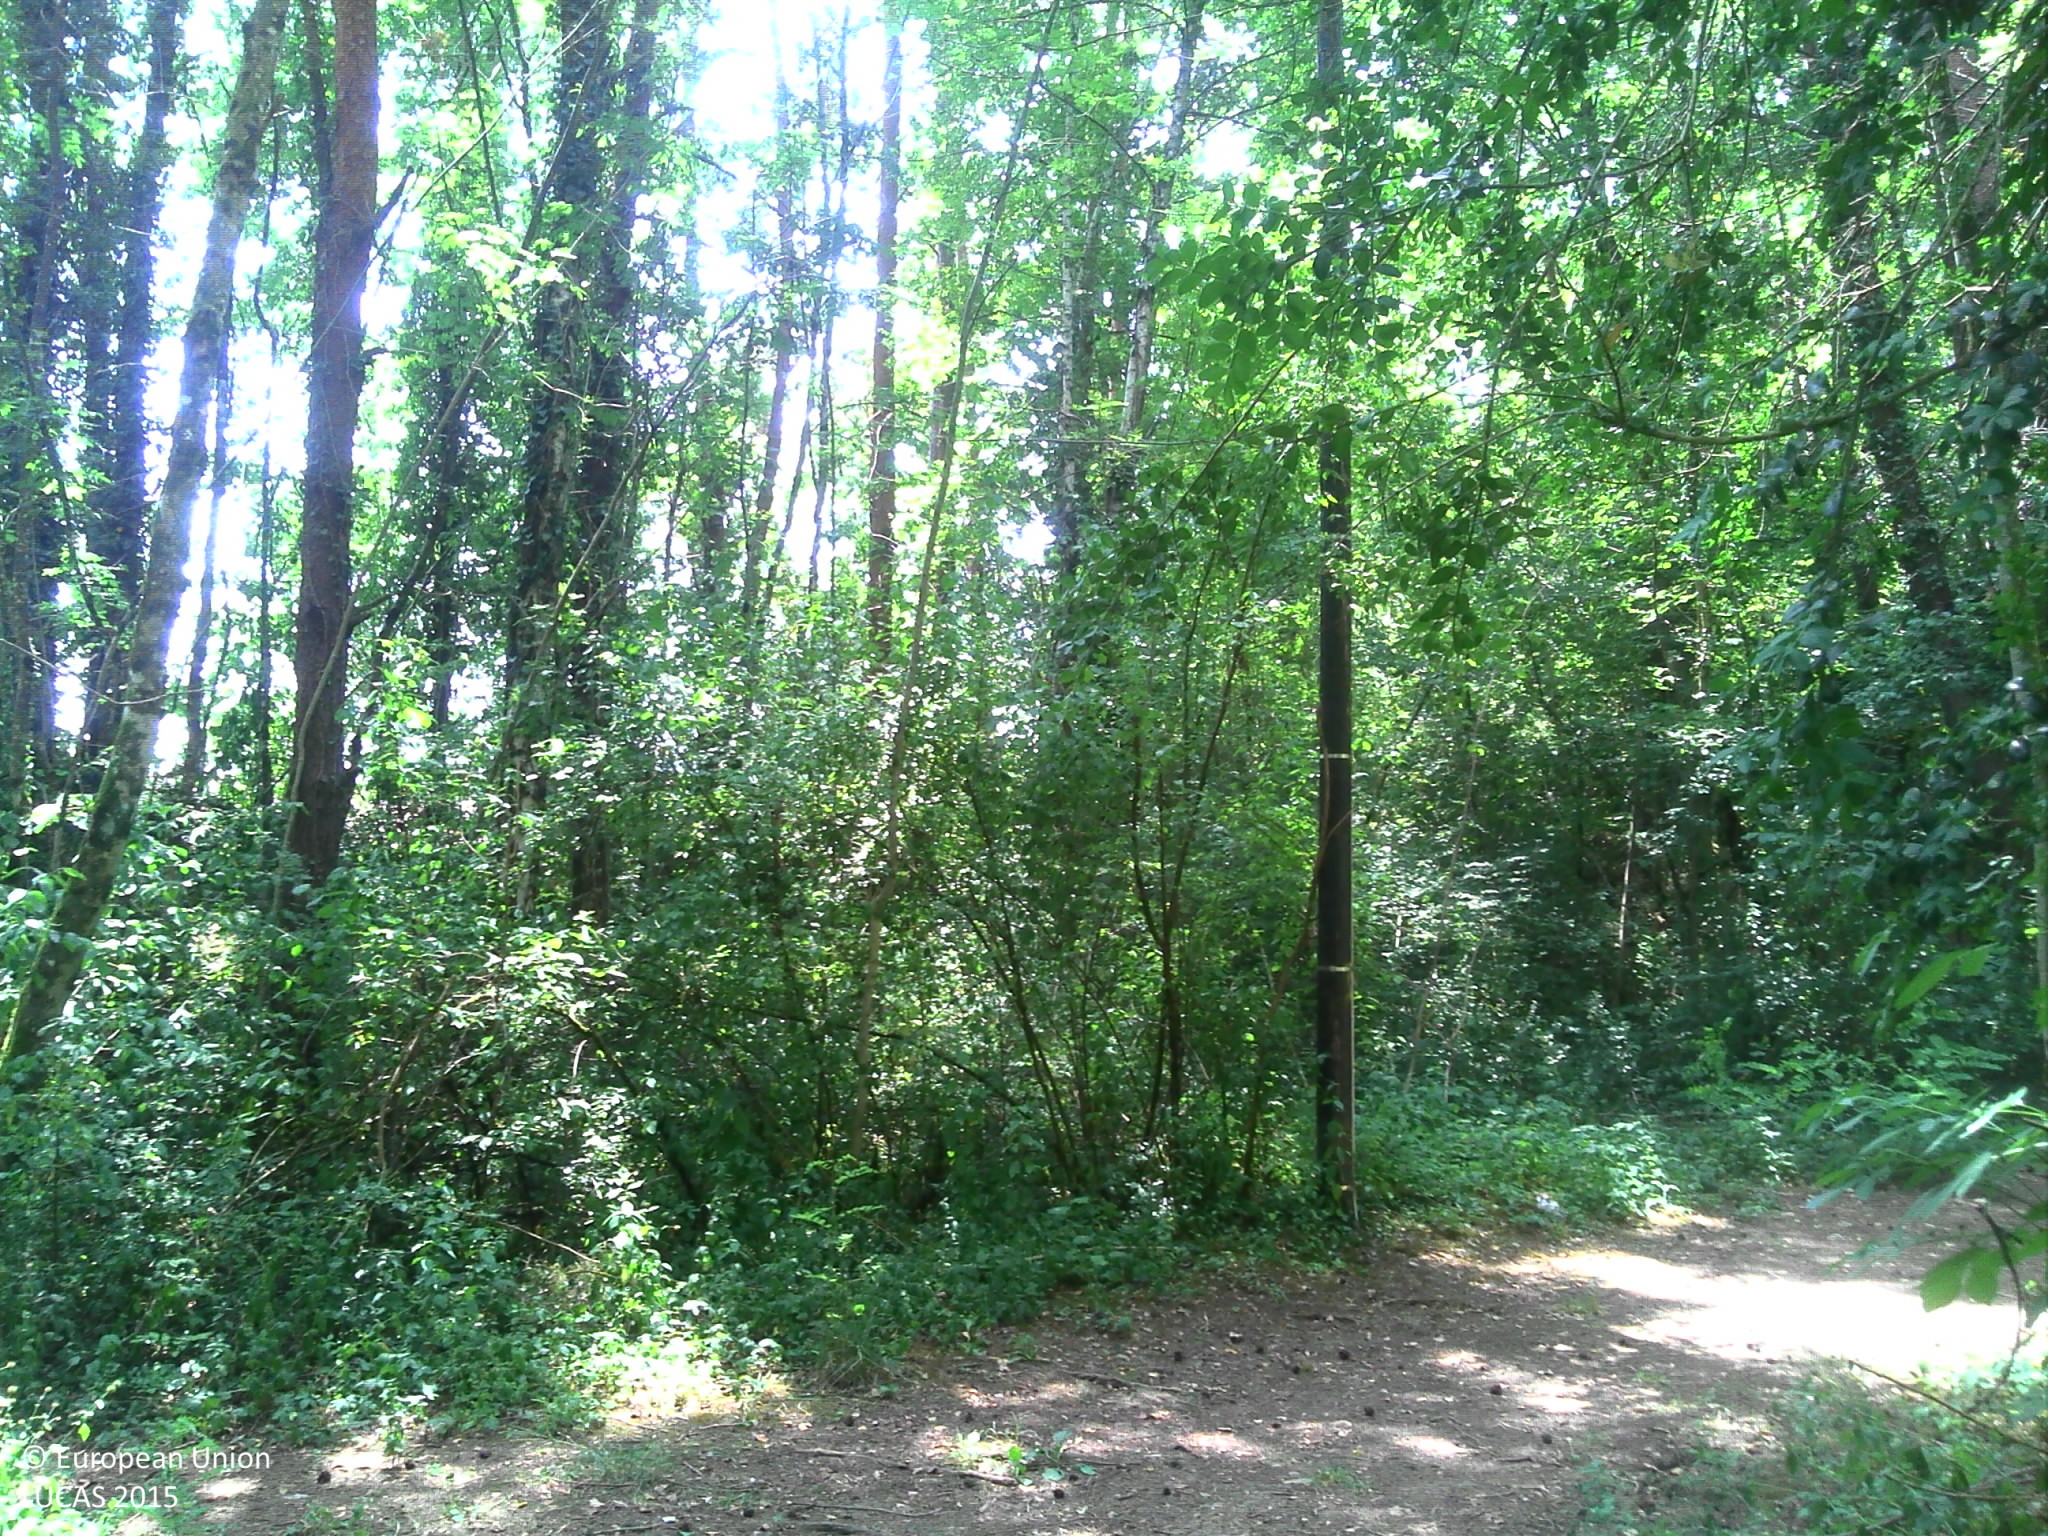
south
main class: Woodland
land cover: Pine dominated mixed woodland
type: hemiboreal forest and nemoral coniferous forest and mixed broadleaved-coniferous forest
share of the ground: > 75 %
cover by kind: coniferous forest trees 30 %, broadleaved forest trees 30 %, herbaceous plants 25 %, lichens and mosses 10 %, shrubs 5 %
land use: Forestry
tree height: > 5 m
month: July
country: FR
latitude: 46.1246
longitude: 6.2894
